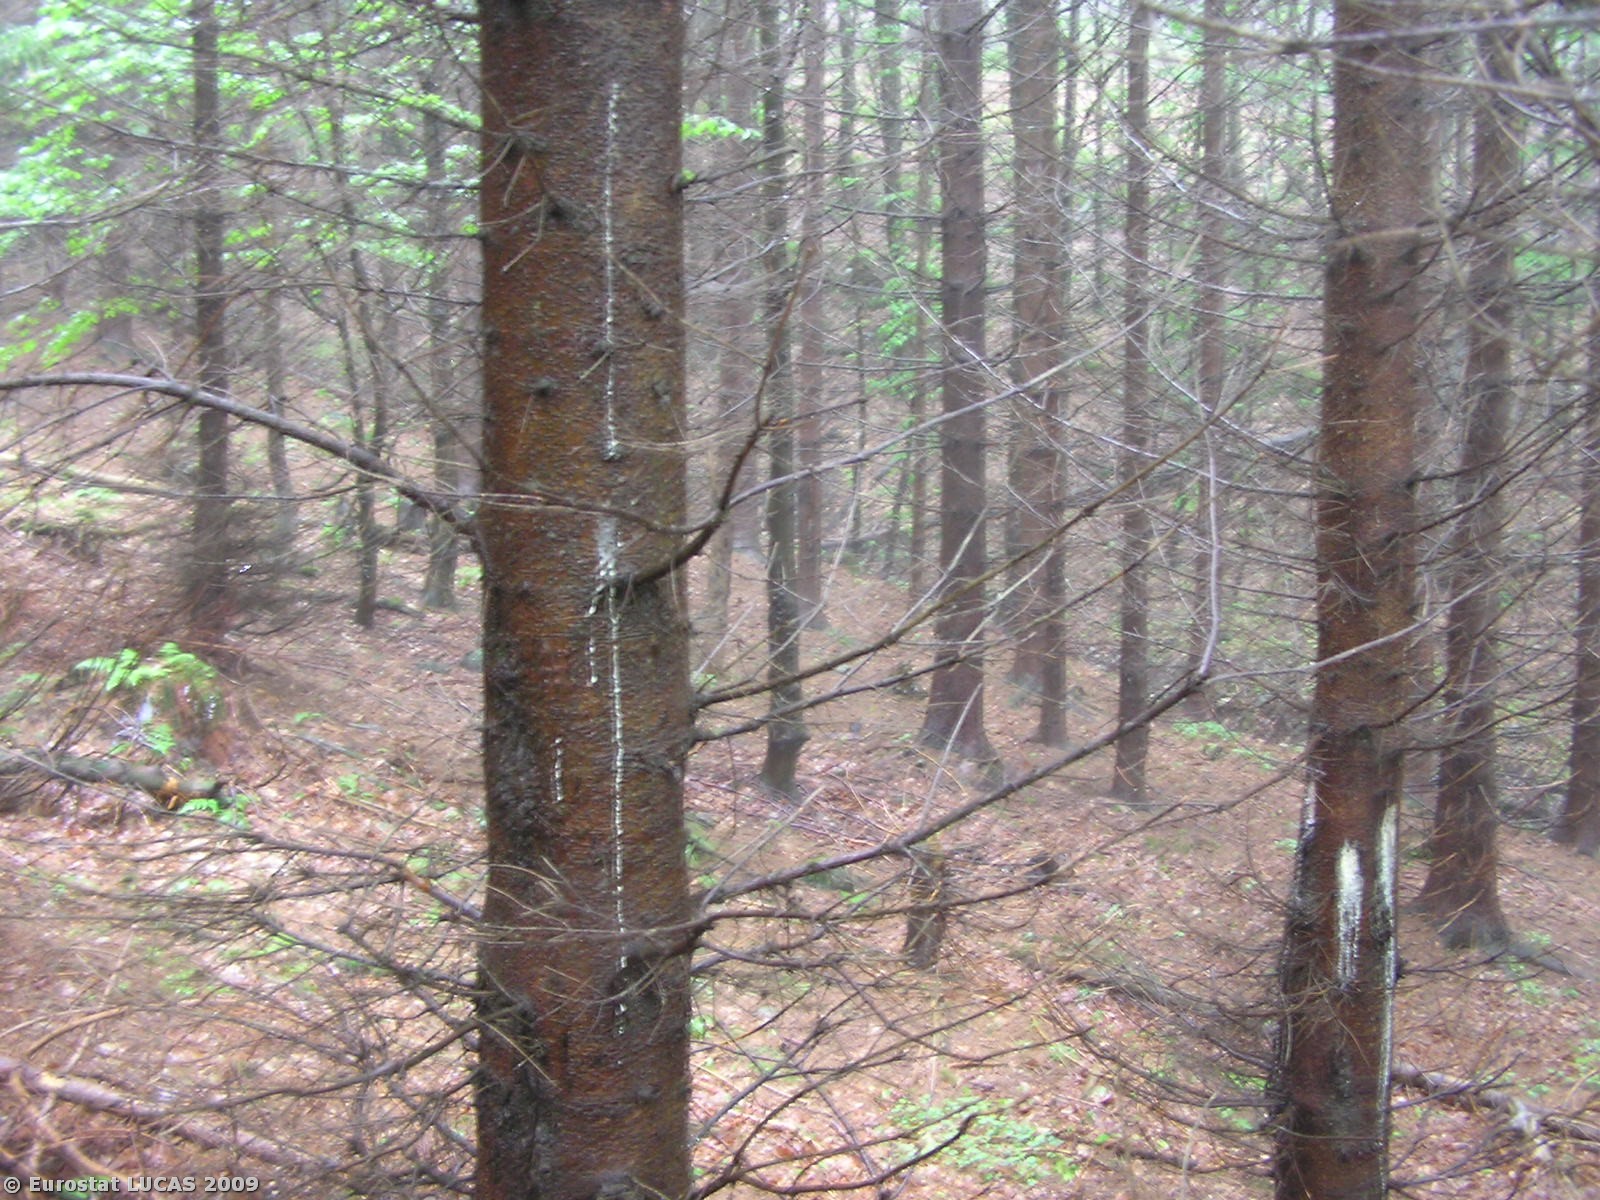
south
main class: Woodland
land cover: Mixed woodland
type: hemiboreal forest and nemoral coniferous forest and mixed broadleaved-coniferous forest
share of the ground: > 75 %
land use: Forestry
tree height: > 5 m
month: June
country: CZ
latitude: 50.1164
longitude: 17.2413
